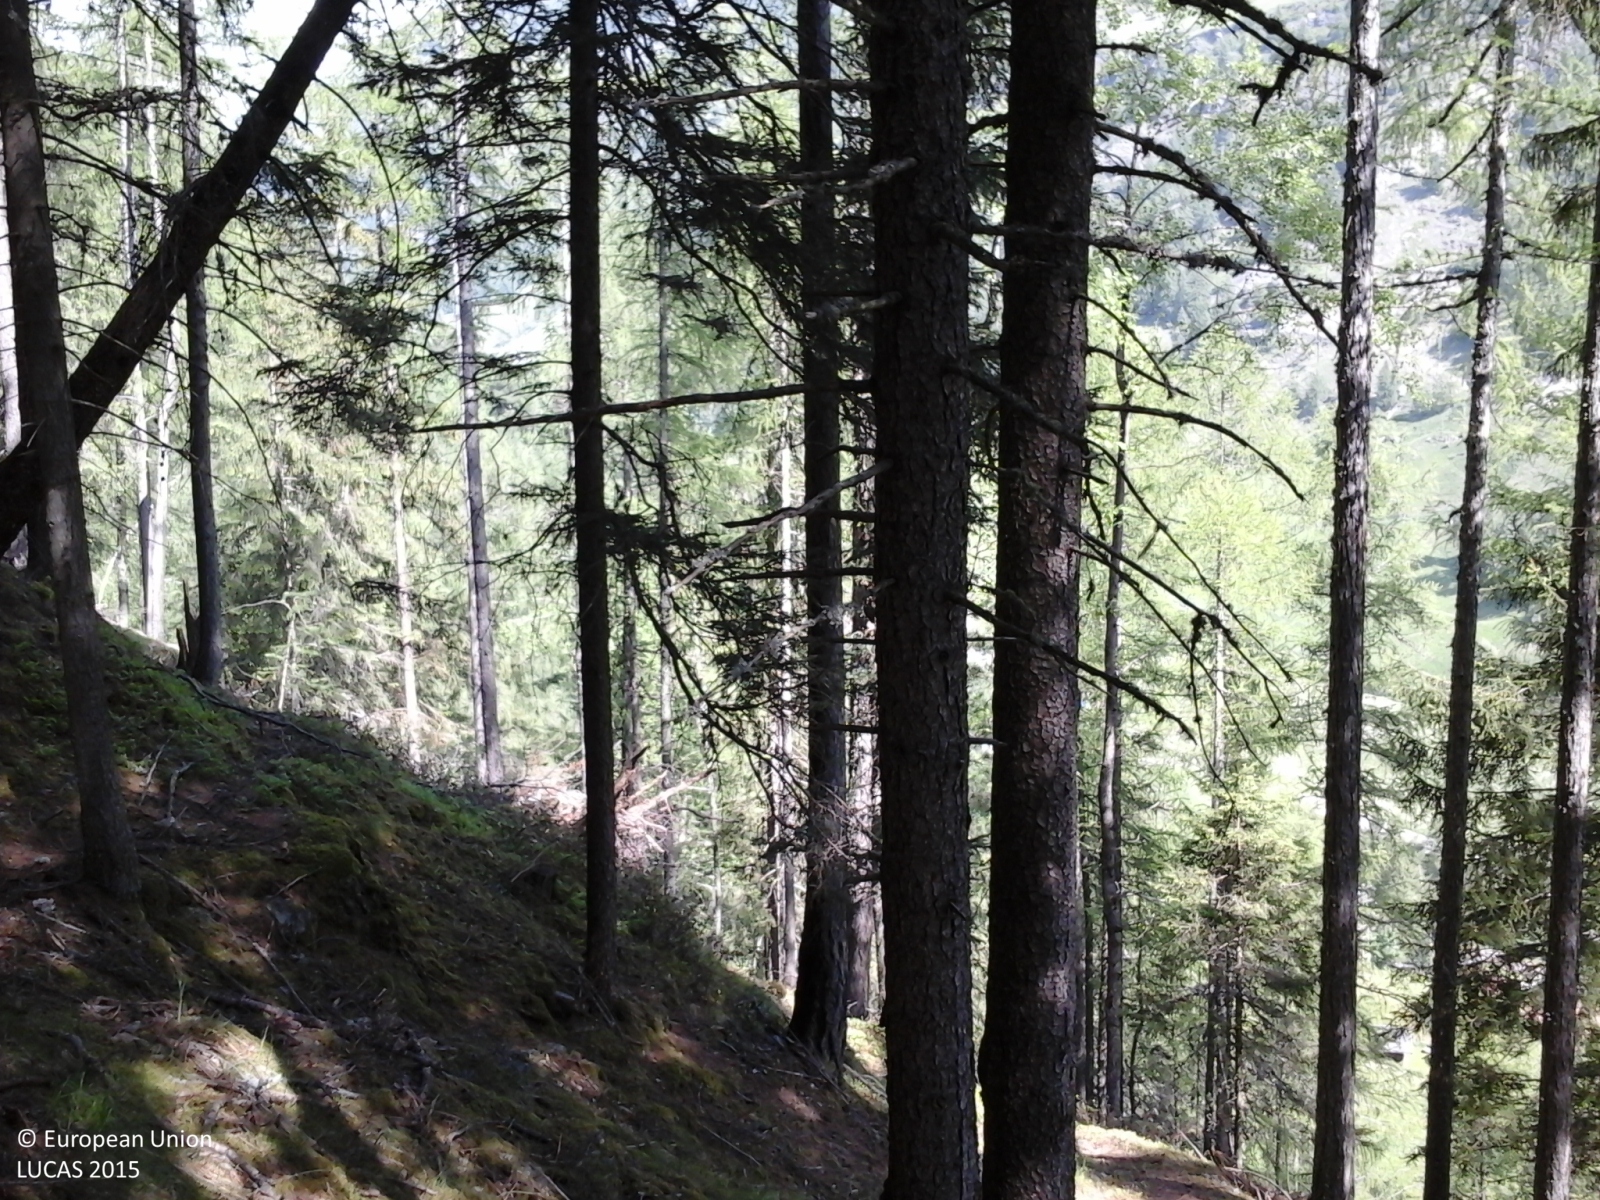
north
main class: Woodland
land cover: Spruce dominated coniferous woodland
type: alpine coniferous forest
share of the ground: > 75 %
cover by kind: coniferous forest trees 100 %
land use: Forestry
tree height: > 5 m
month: June
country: IT
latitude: 46.7076
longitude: 10.9015
